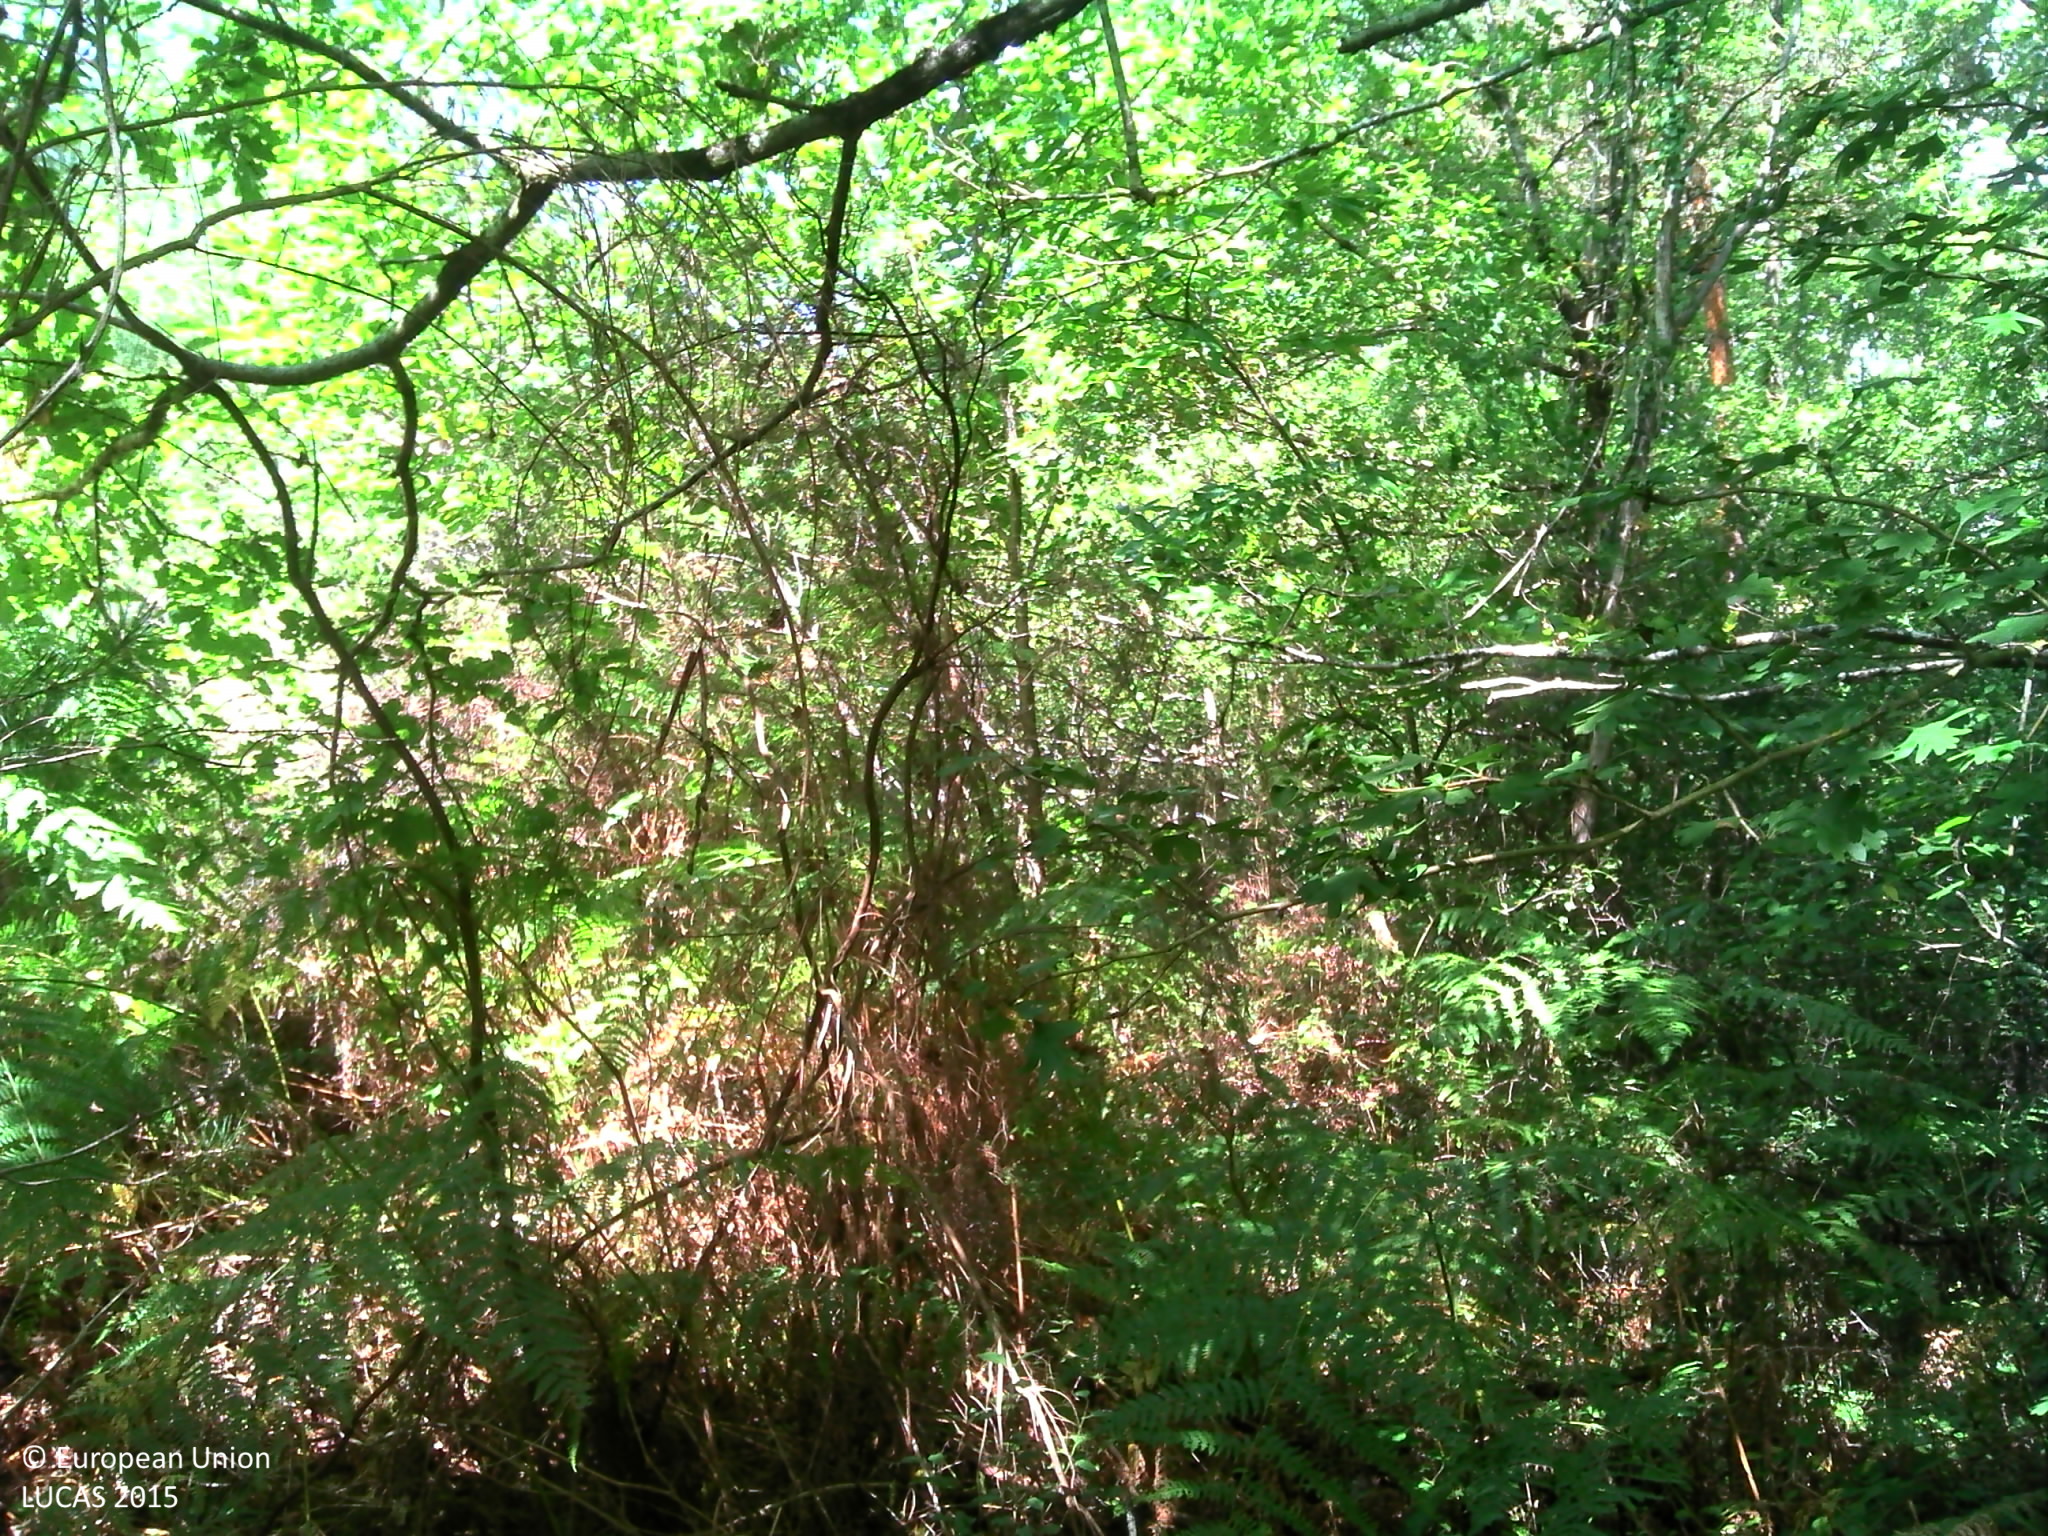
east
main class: Woodland
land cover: Broadleaved woodland
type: mesophytic deciduous forest
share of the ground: > 75 %
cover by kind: broadleaved forest trees 70 %, shrubs 10 %, herbaceous plants 10 %, coniferous forest trees 5 %, lichens and mosses 5 %
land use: Forestry
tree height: > 5 m
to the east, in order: Broadleaved woodland; Nuts trees
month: August
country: FR
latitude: 45.3345
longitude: 0.7640
